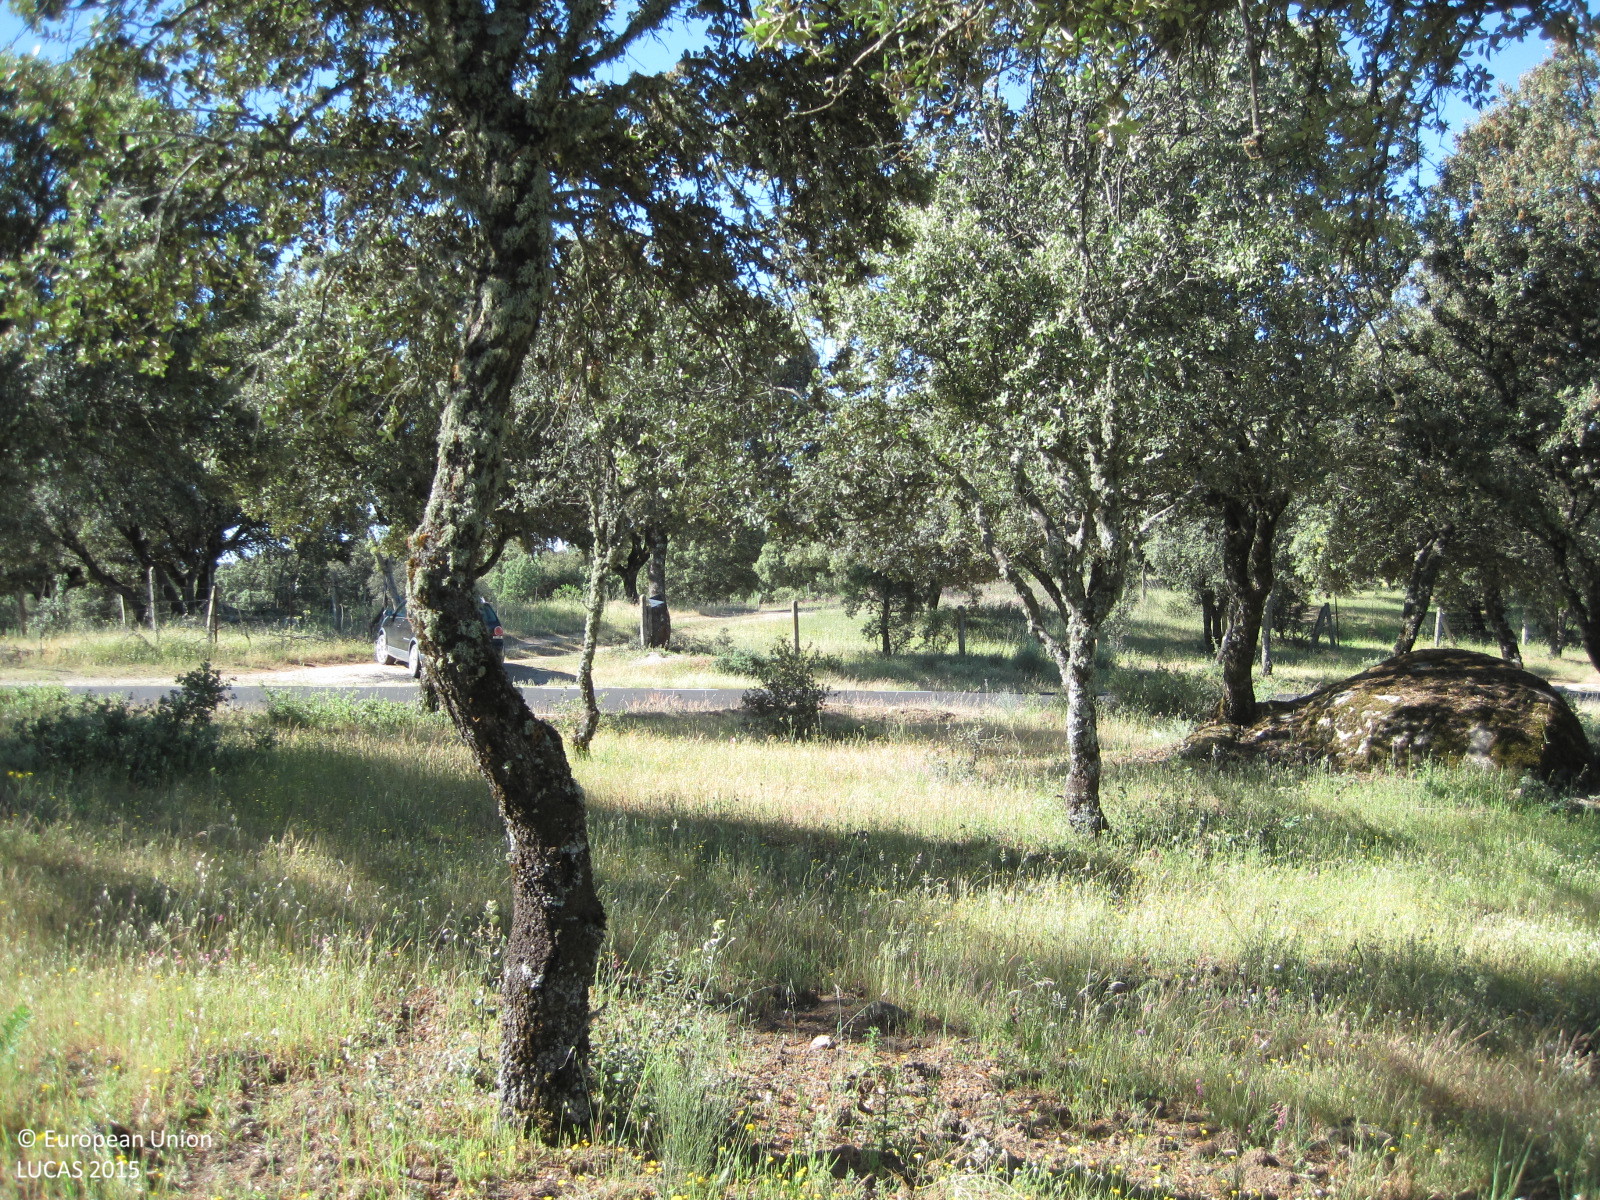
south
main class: Woodland
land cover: Broadleaved woodland
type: broadleaved evergreen forest
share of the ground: > 75 %
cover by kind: shrubs 85 %, broadleaved forest trees 15 %
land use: Semi-natural and natural areas not in use
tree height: > 5 m
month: May
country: ES
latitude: 40.1609
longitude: -4.8325
